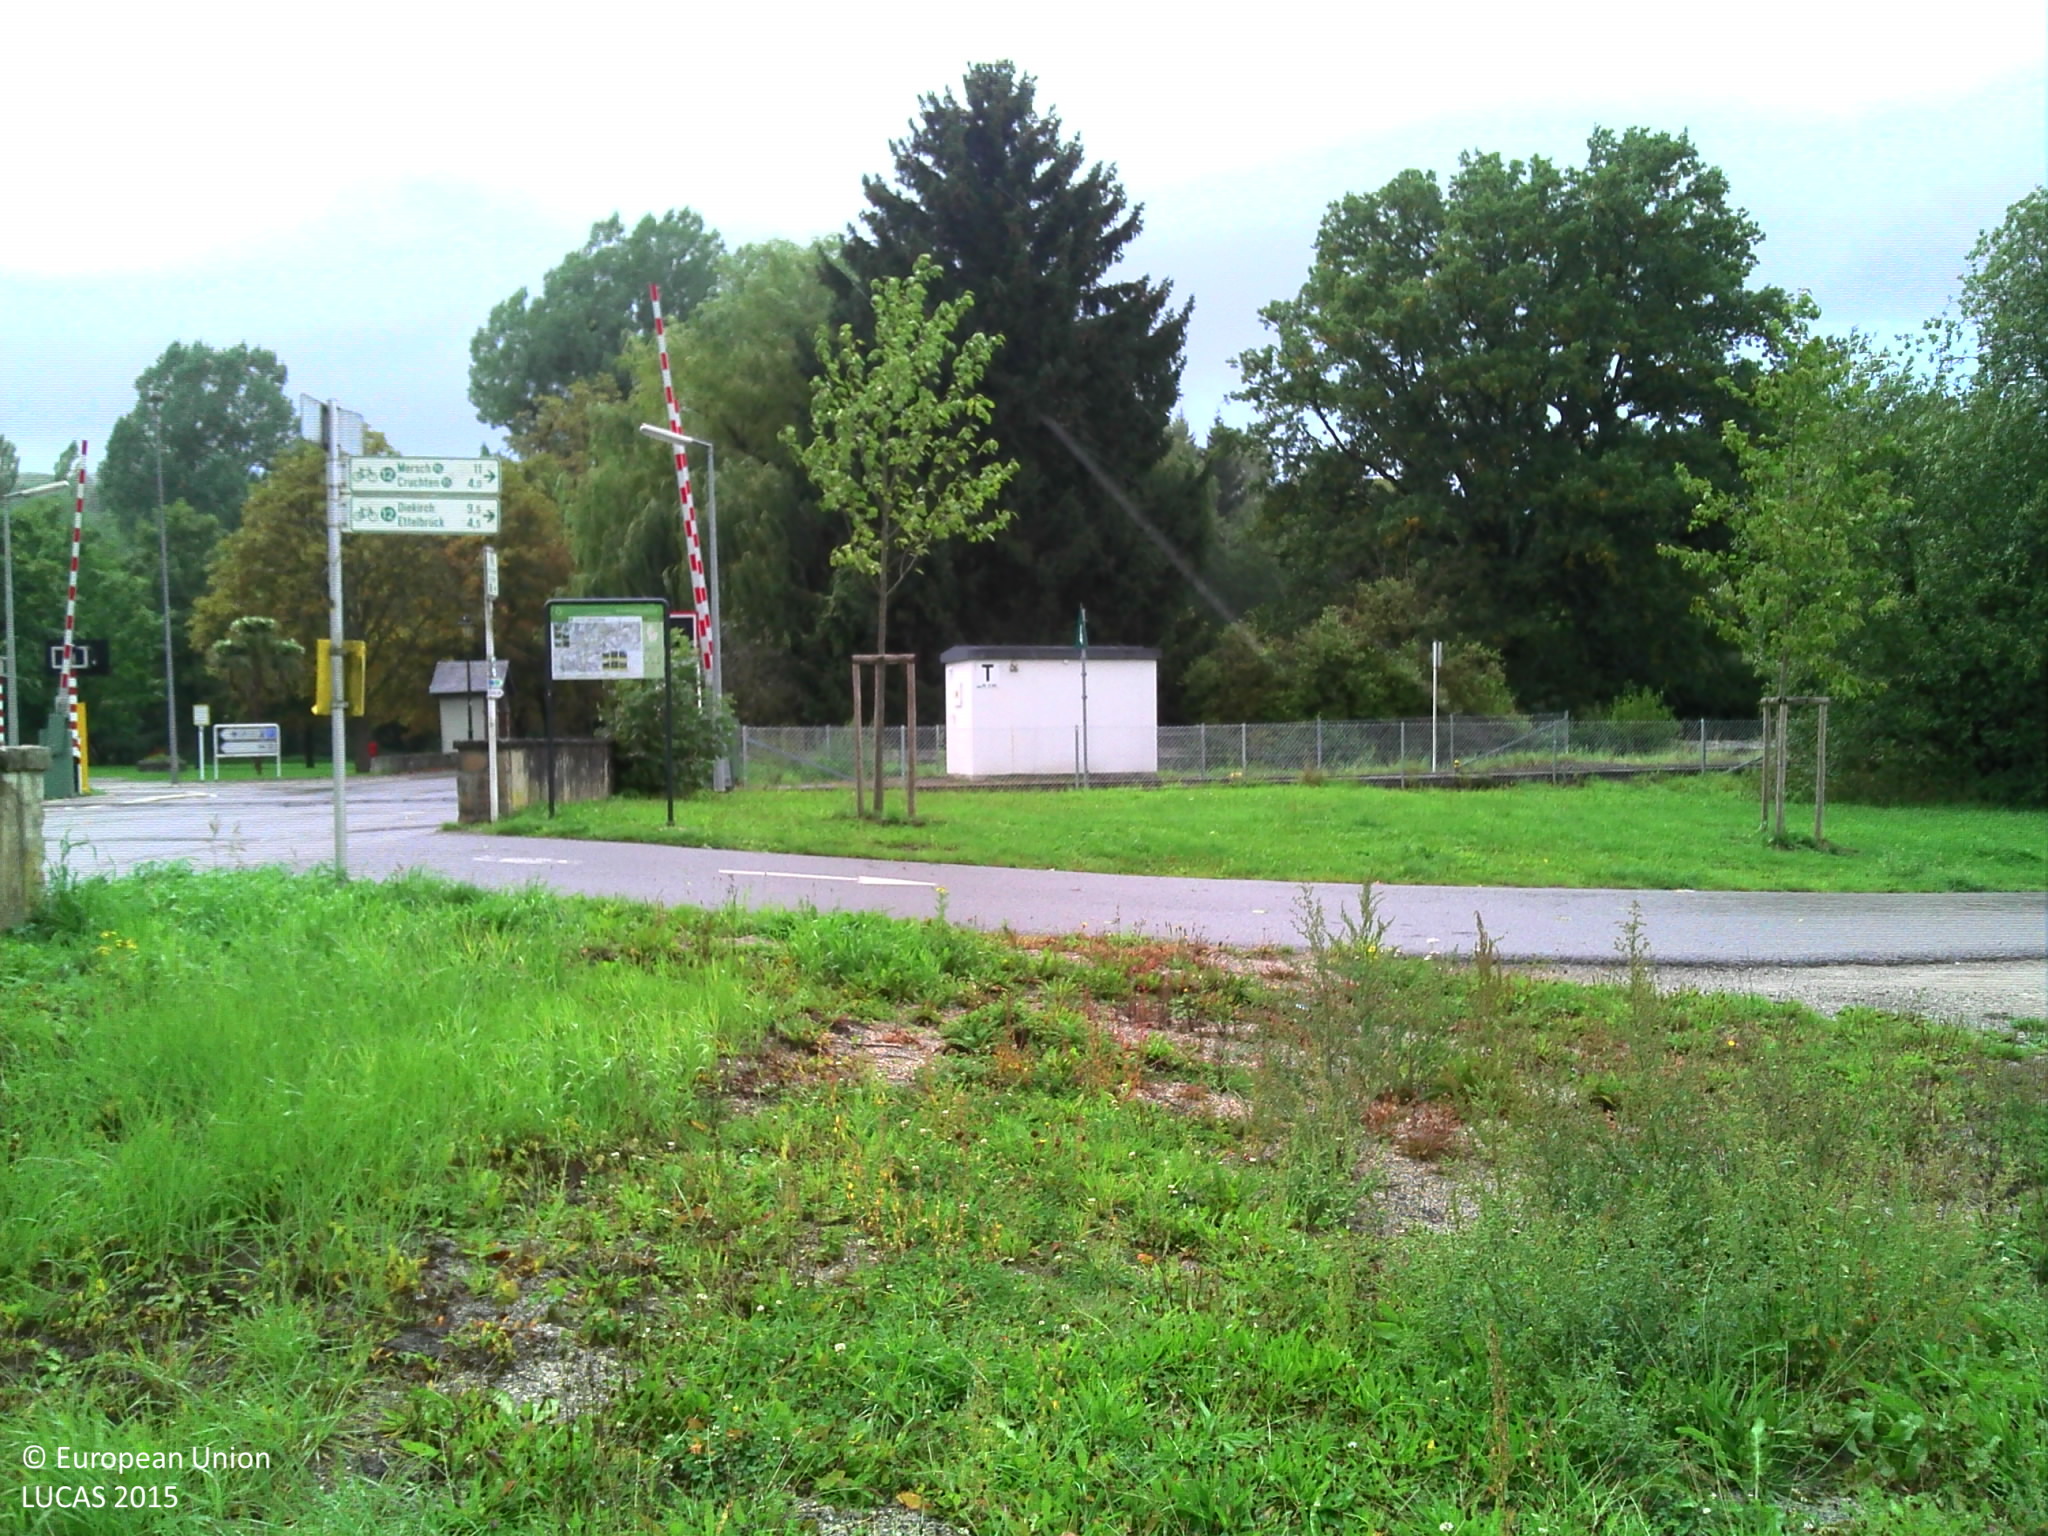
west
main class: Grassland
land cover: Spontaneously vegetated surfaces
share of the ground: > 75 %
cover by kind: herbaceous plants 90 %, unconsolidated bare surface 10 %
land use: Abandoned areas
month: September
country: LU
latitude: 49.8113
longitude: 6.0944
